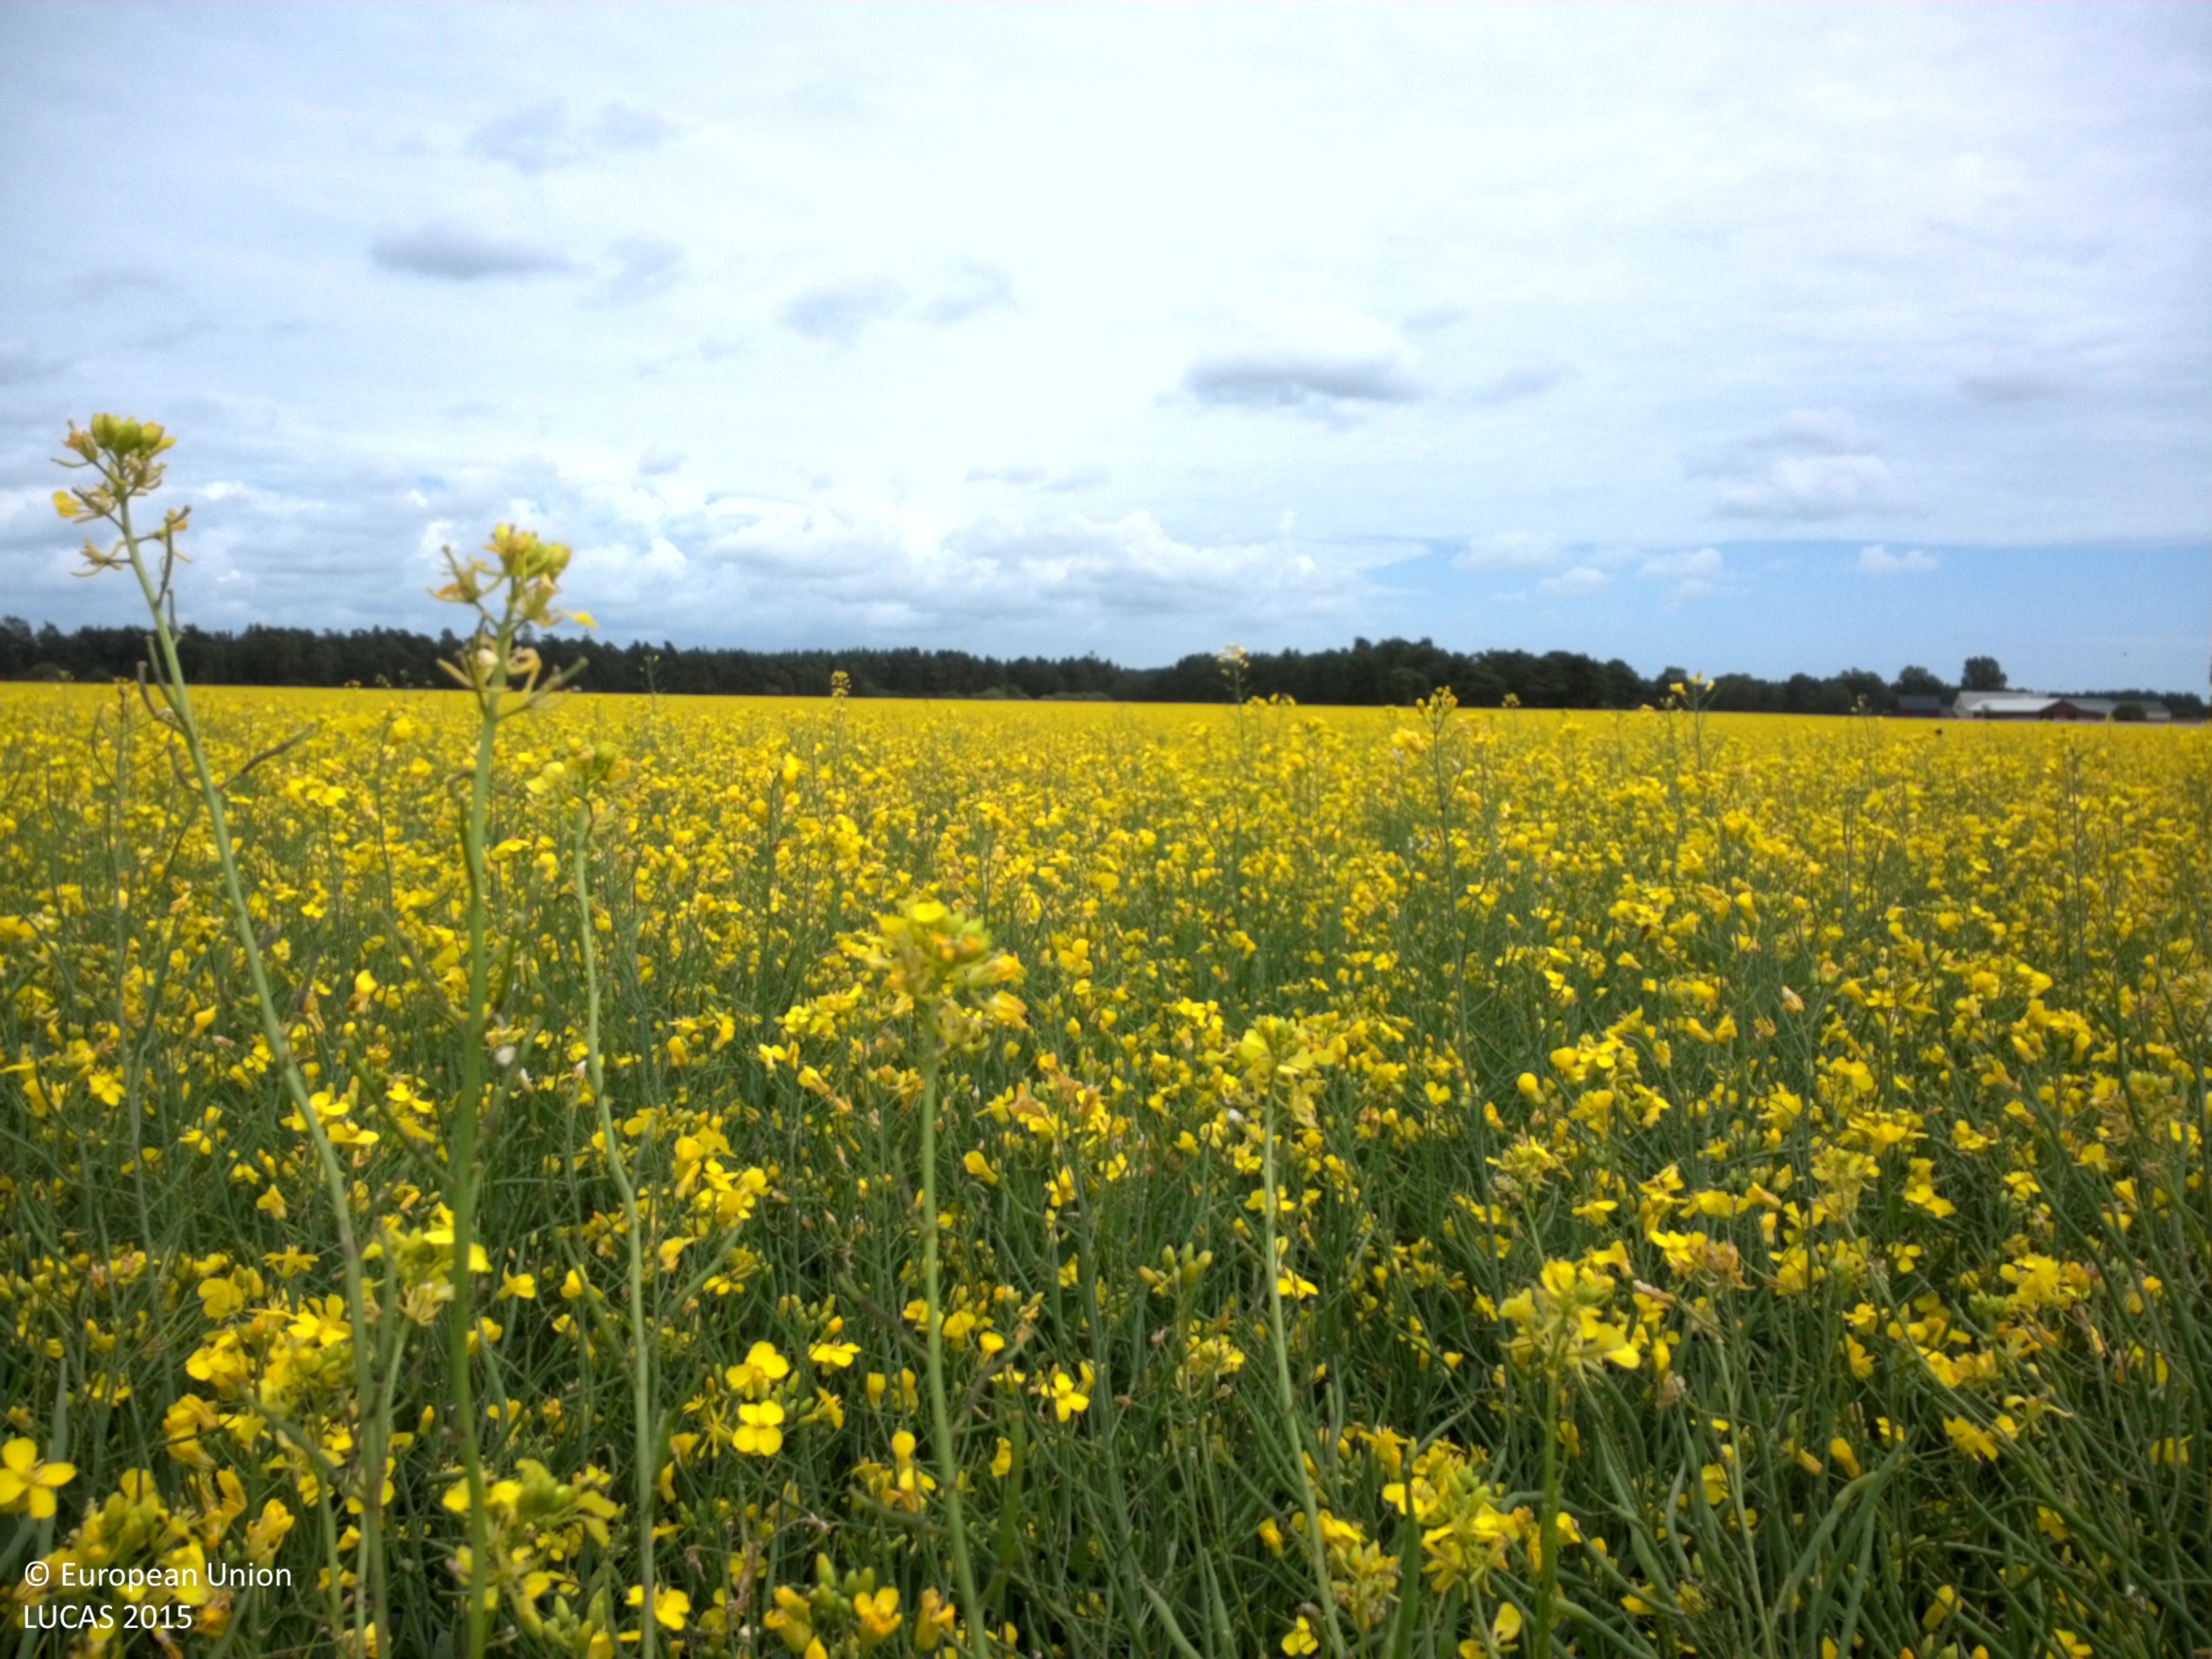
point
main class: Cropland
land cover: Rape and turnip rape
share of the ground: > 75 %
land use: Agriculture (excluding fallow land and kitchen gardens)
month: July
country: SE
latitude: 57.2478
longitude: 18.4448
